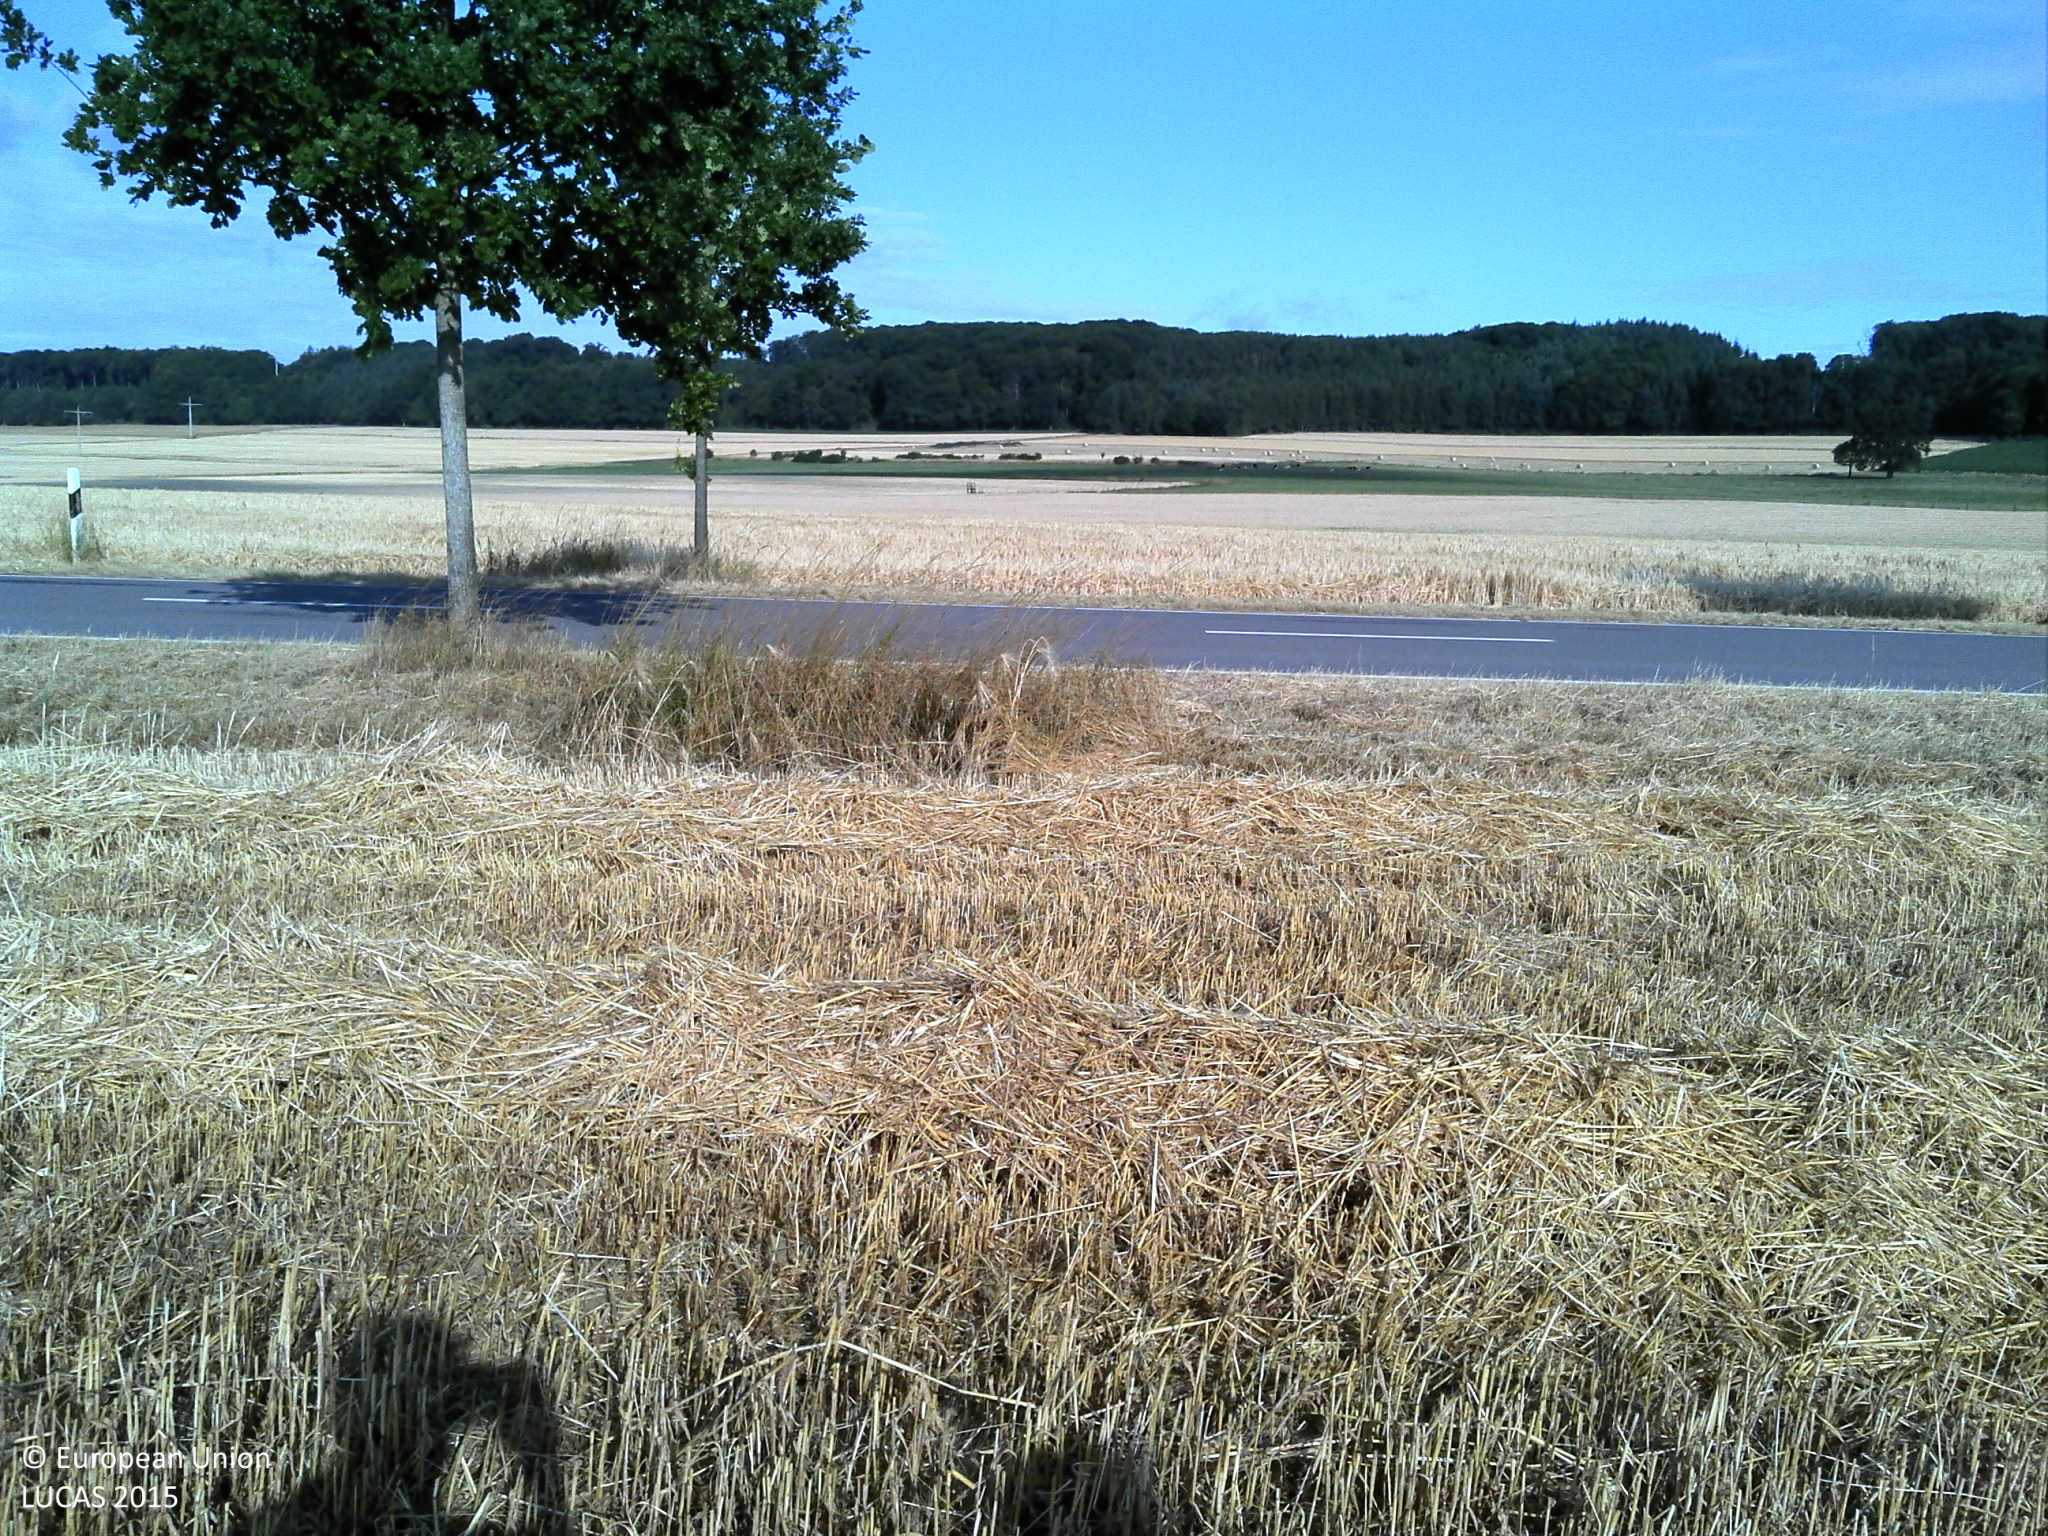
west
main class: Cropland
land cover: Barley
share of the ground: > 75 %
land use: Agriculture (excluding fallow land and kitchen gardens)
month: July
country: LU
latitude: 49.5296
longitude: 6.2830
